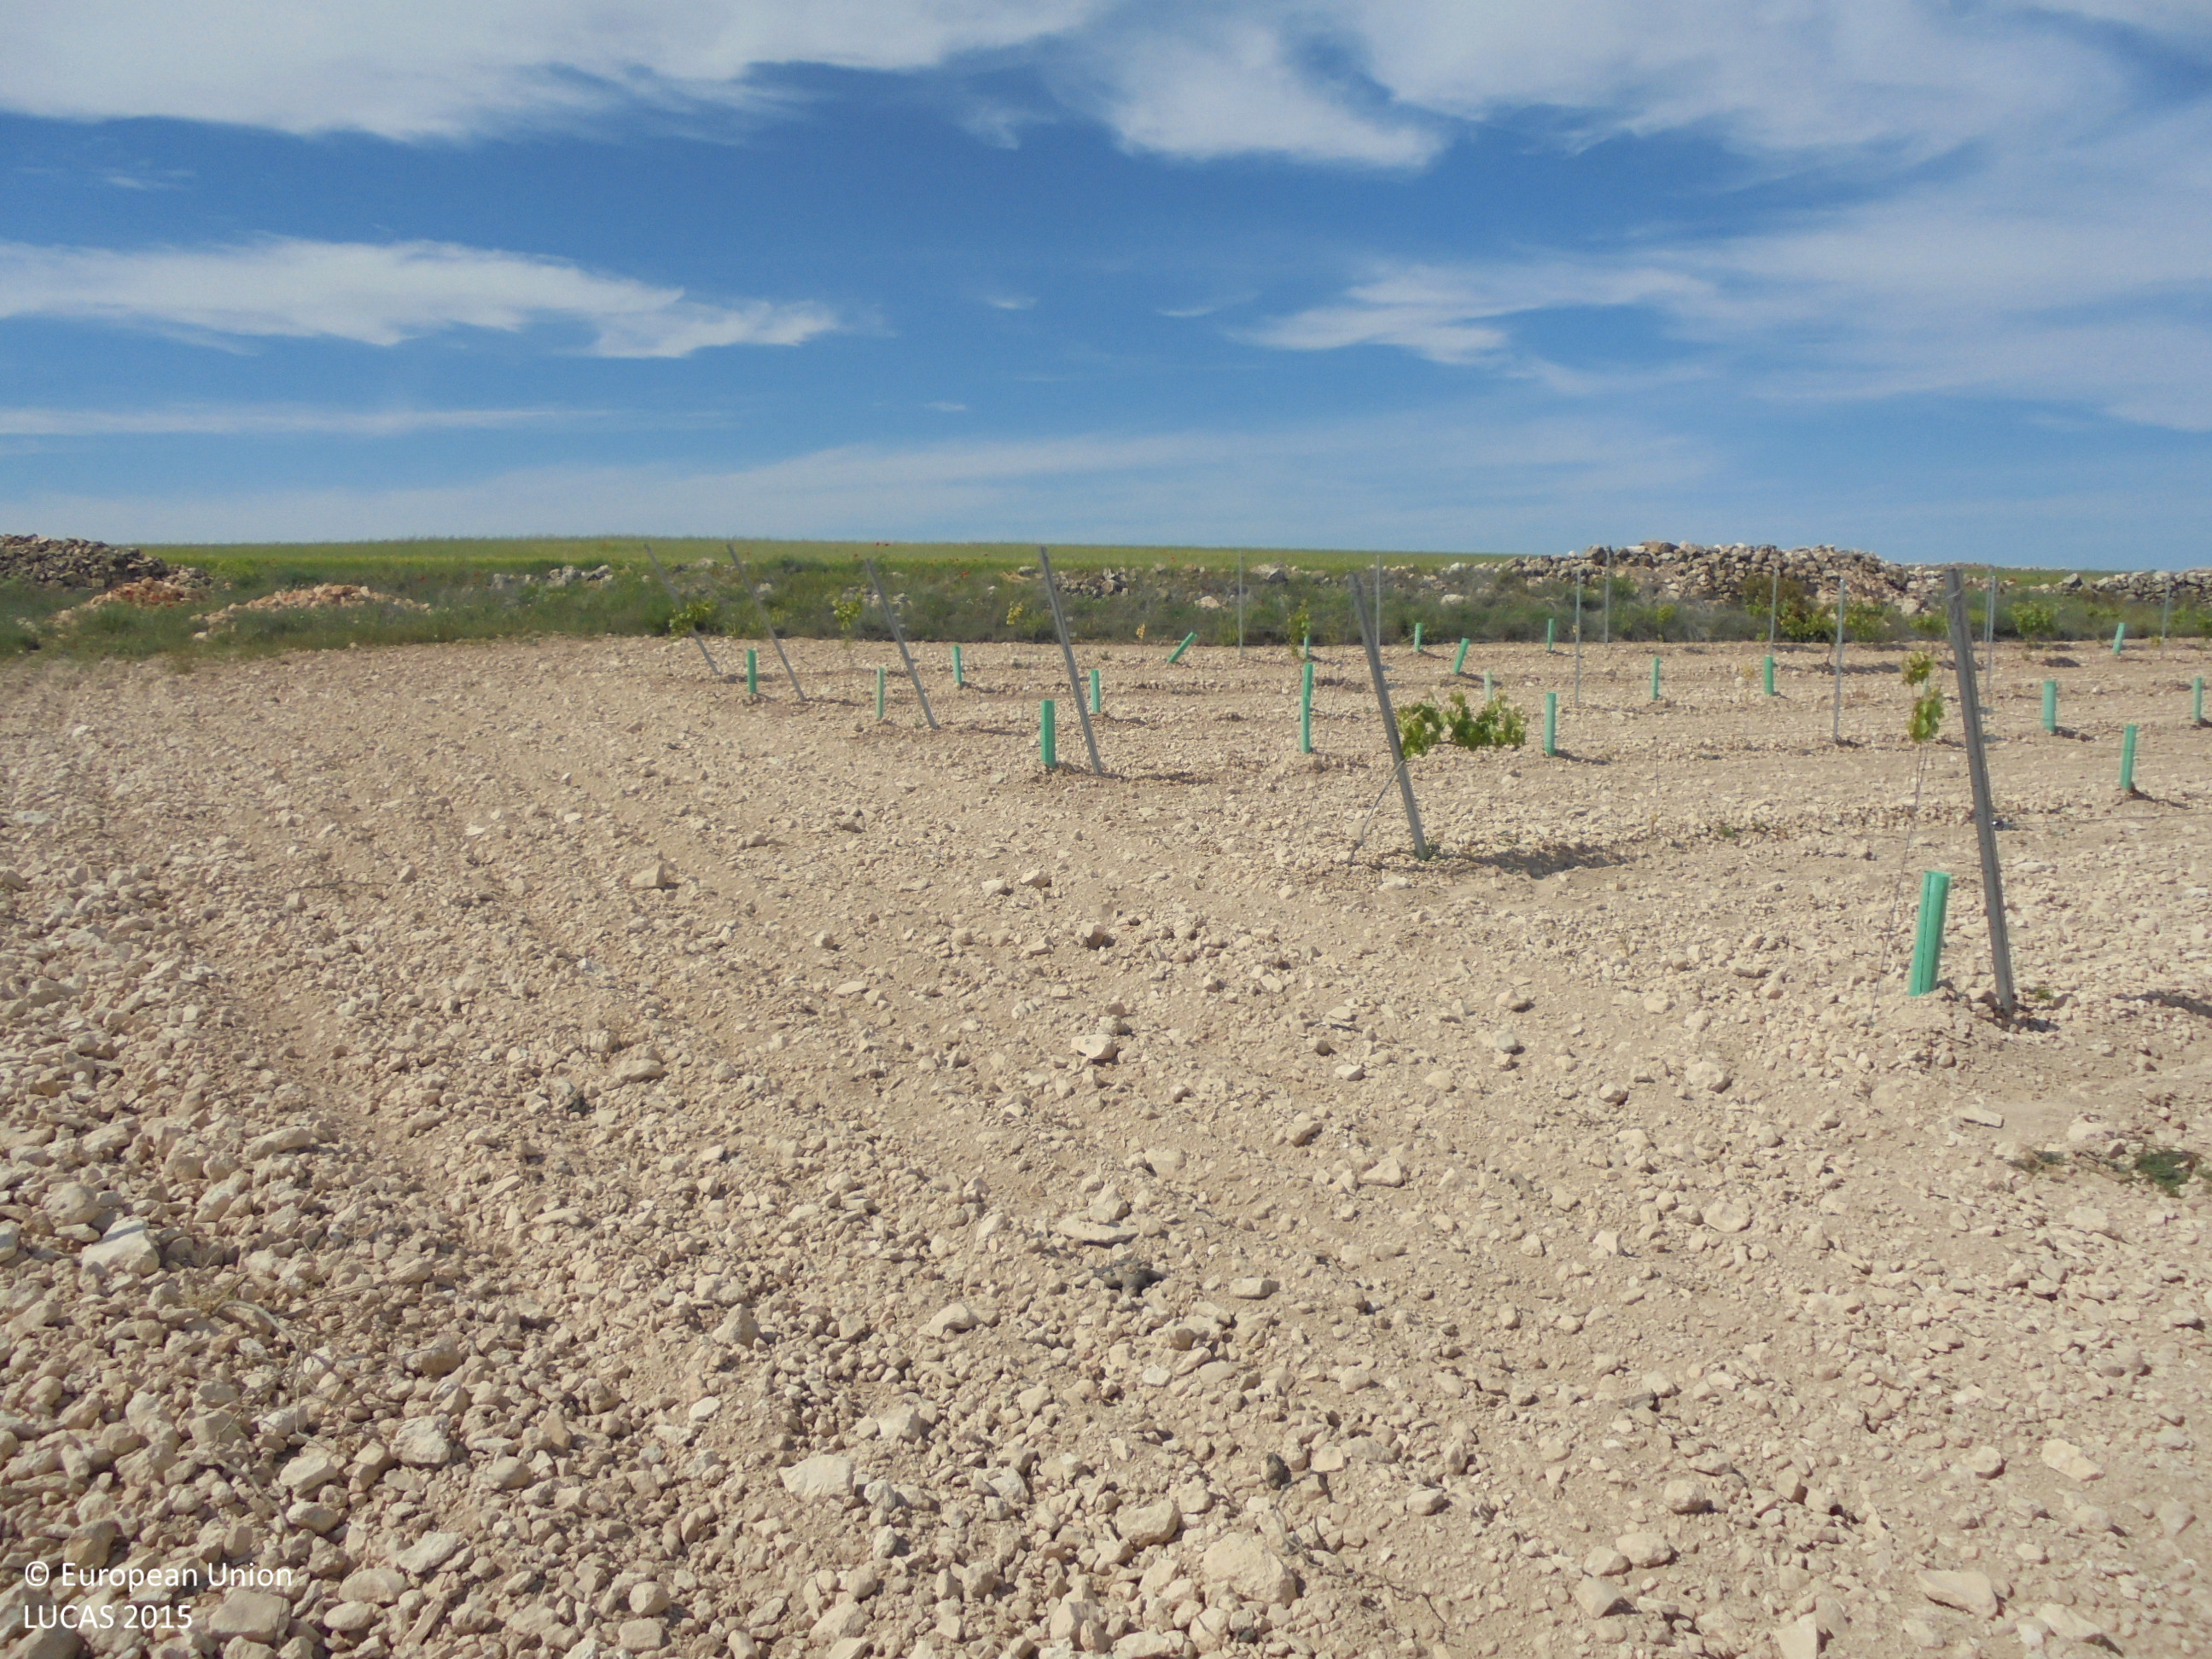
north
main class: Grassland
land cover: Spontaneously vegetated surfaces
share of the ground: 10 - 25 %
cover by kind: unconsolidated bare surface 70 %, herbaceous plants 30 %
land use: Agriculture (excluding fallow land and kitchen gardens)
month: May
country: ES
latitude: 39.1268
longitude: -1.6955
